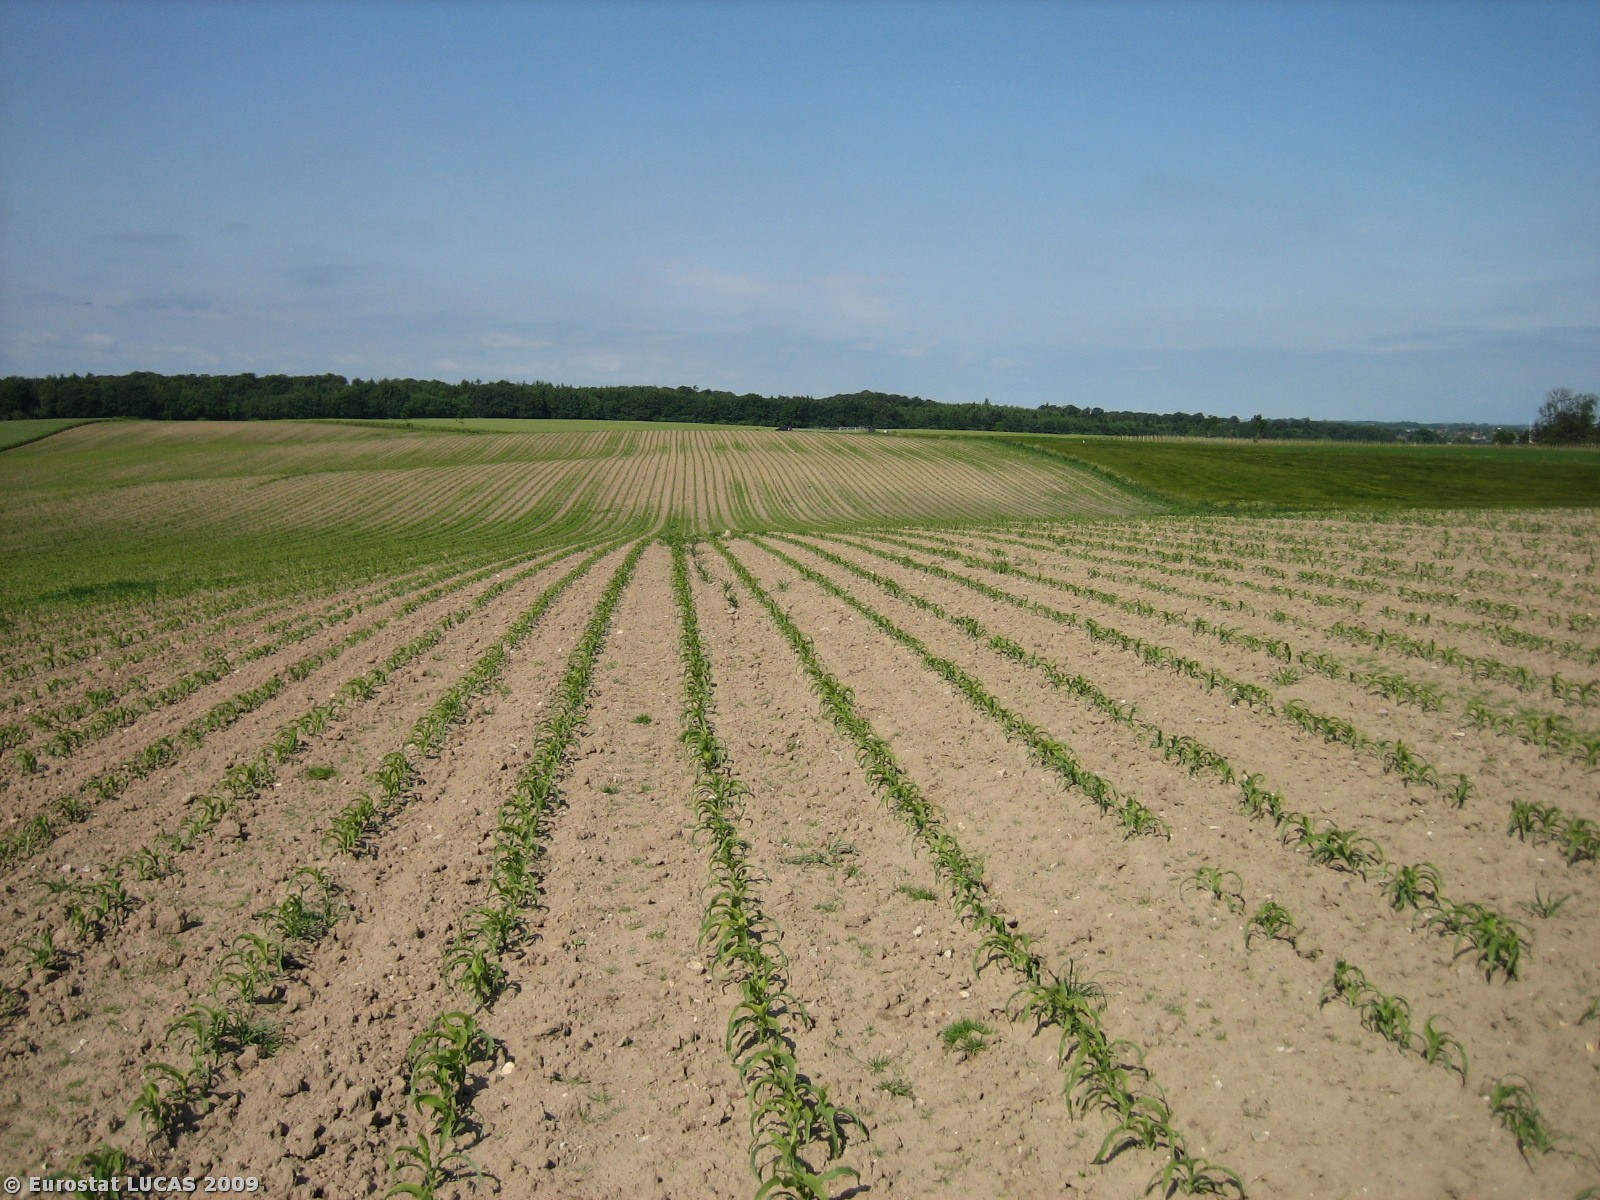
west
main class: Cropland
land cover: Maize
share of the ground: < 10 %
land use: Agriculture (excluding fallow land and kitchen gardens)
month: June
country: DK
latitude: 55.9181
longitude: 9.8881
